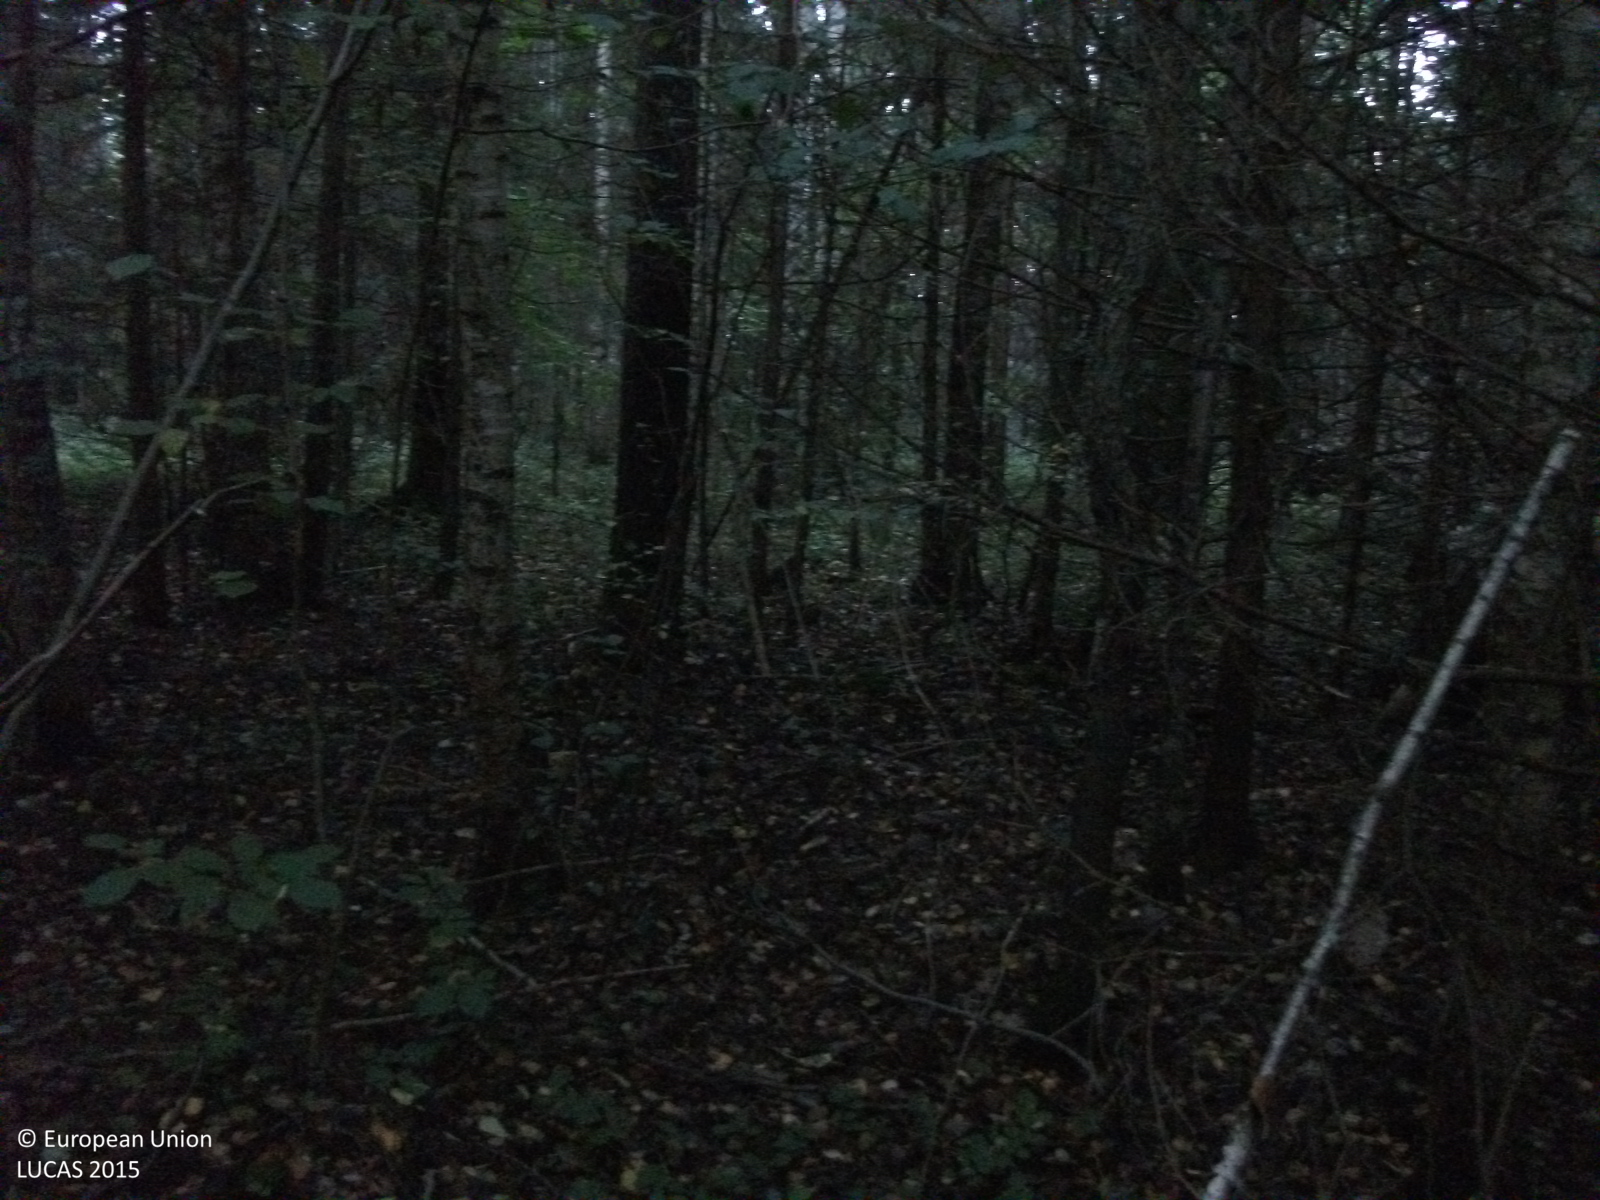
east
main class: Woodland
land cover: Spruce dominated mixed woodland
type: hemiboreal forest and nemoral coniferous forest and mixed broadleaved-coniferous forest
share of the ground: > 75 %
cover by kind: coniferous forest trees 55 %, broadleaved forest trees 35 %, herbaceous plants 5 %, unconsolidated bare surface 5 %
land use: Forestry
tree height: > 5 m
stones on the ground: < 10 %
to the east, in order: Spruce dominated mixed woodland; Broadleaved woodland; Ditches and canals; Broadleaved woodland; Ditches and canals; Broadleaved woodland
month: September
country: LV
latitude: 57.7848
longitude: 24.7438
